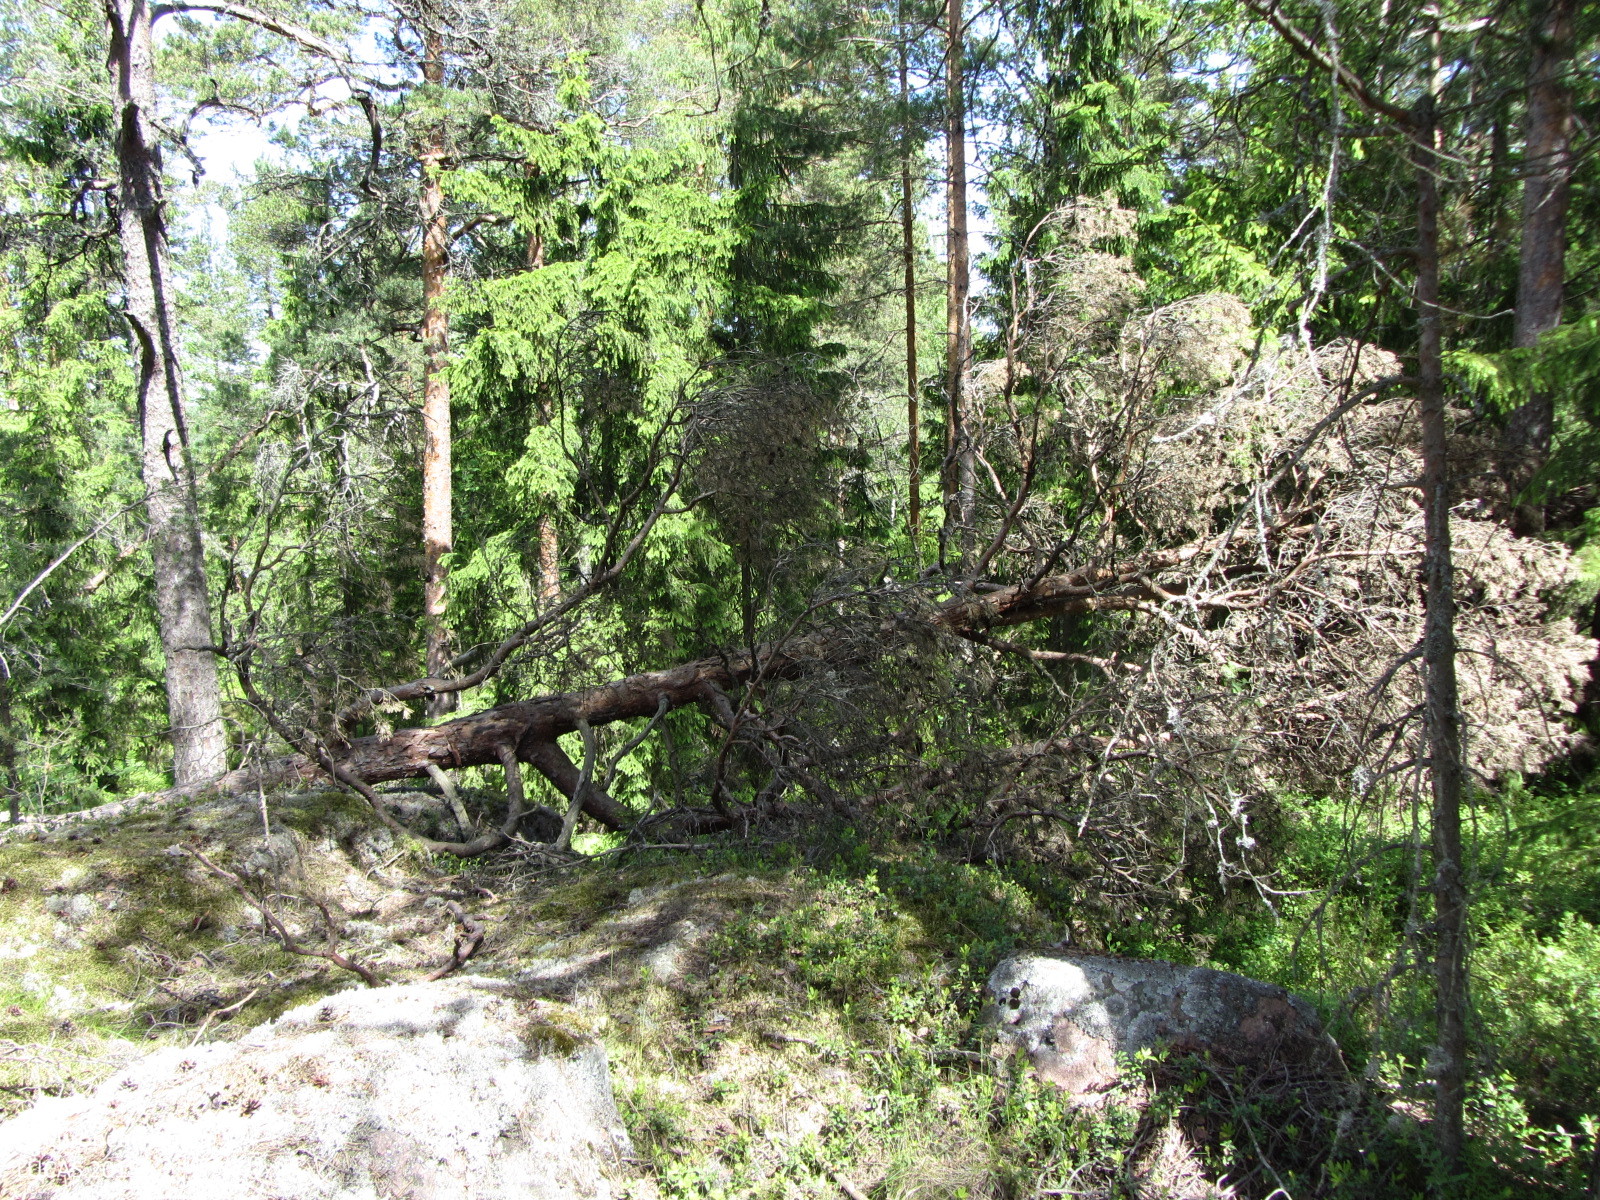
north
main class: Woodland
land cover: Pine dominated coniferous woodland
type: boreal forest
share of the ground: > 75 %
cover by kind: coniferous forest trees 70 %, shrubs 10 %, consolidated bare surface 10 %, broadleaved forest trees 5 %, lichens and mosses 5 %
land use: Forestry
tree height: > 5 m
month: June
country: FI
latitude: 60.1658
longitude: 24.6177
